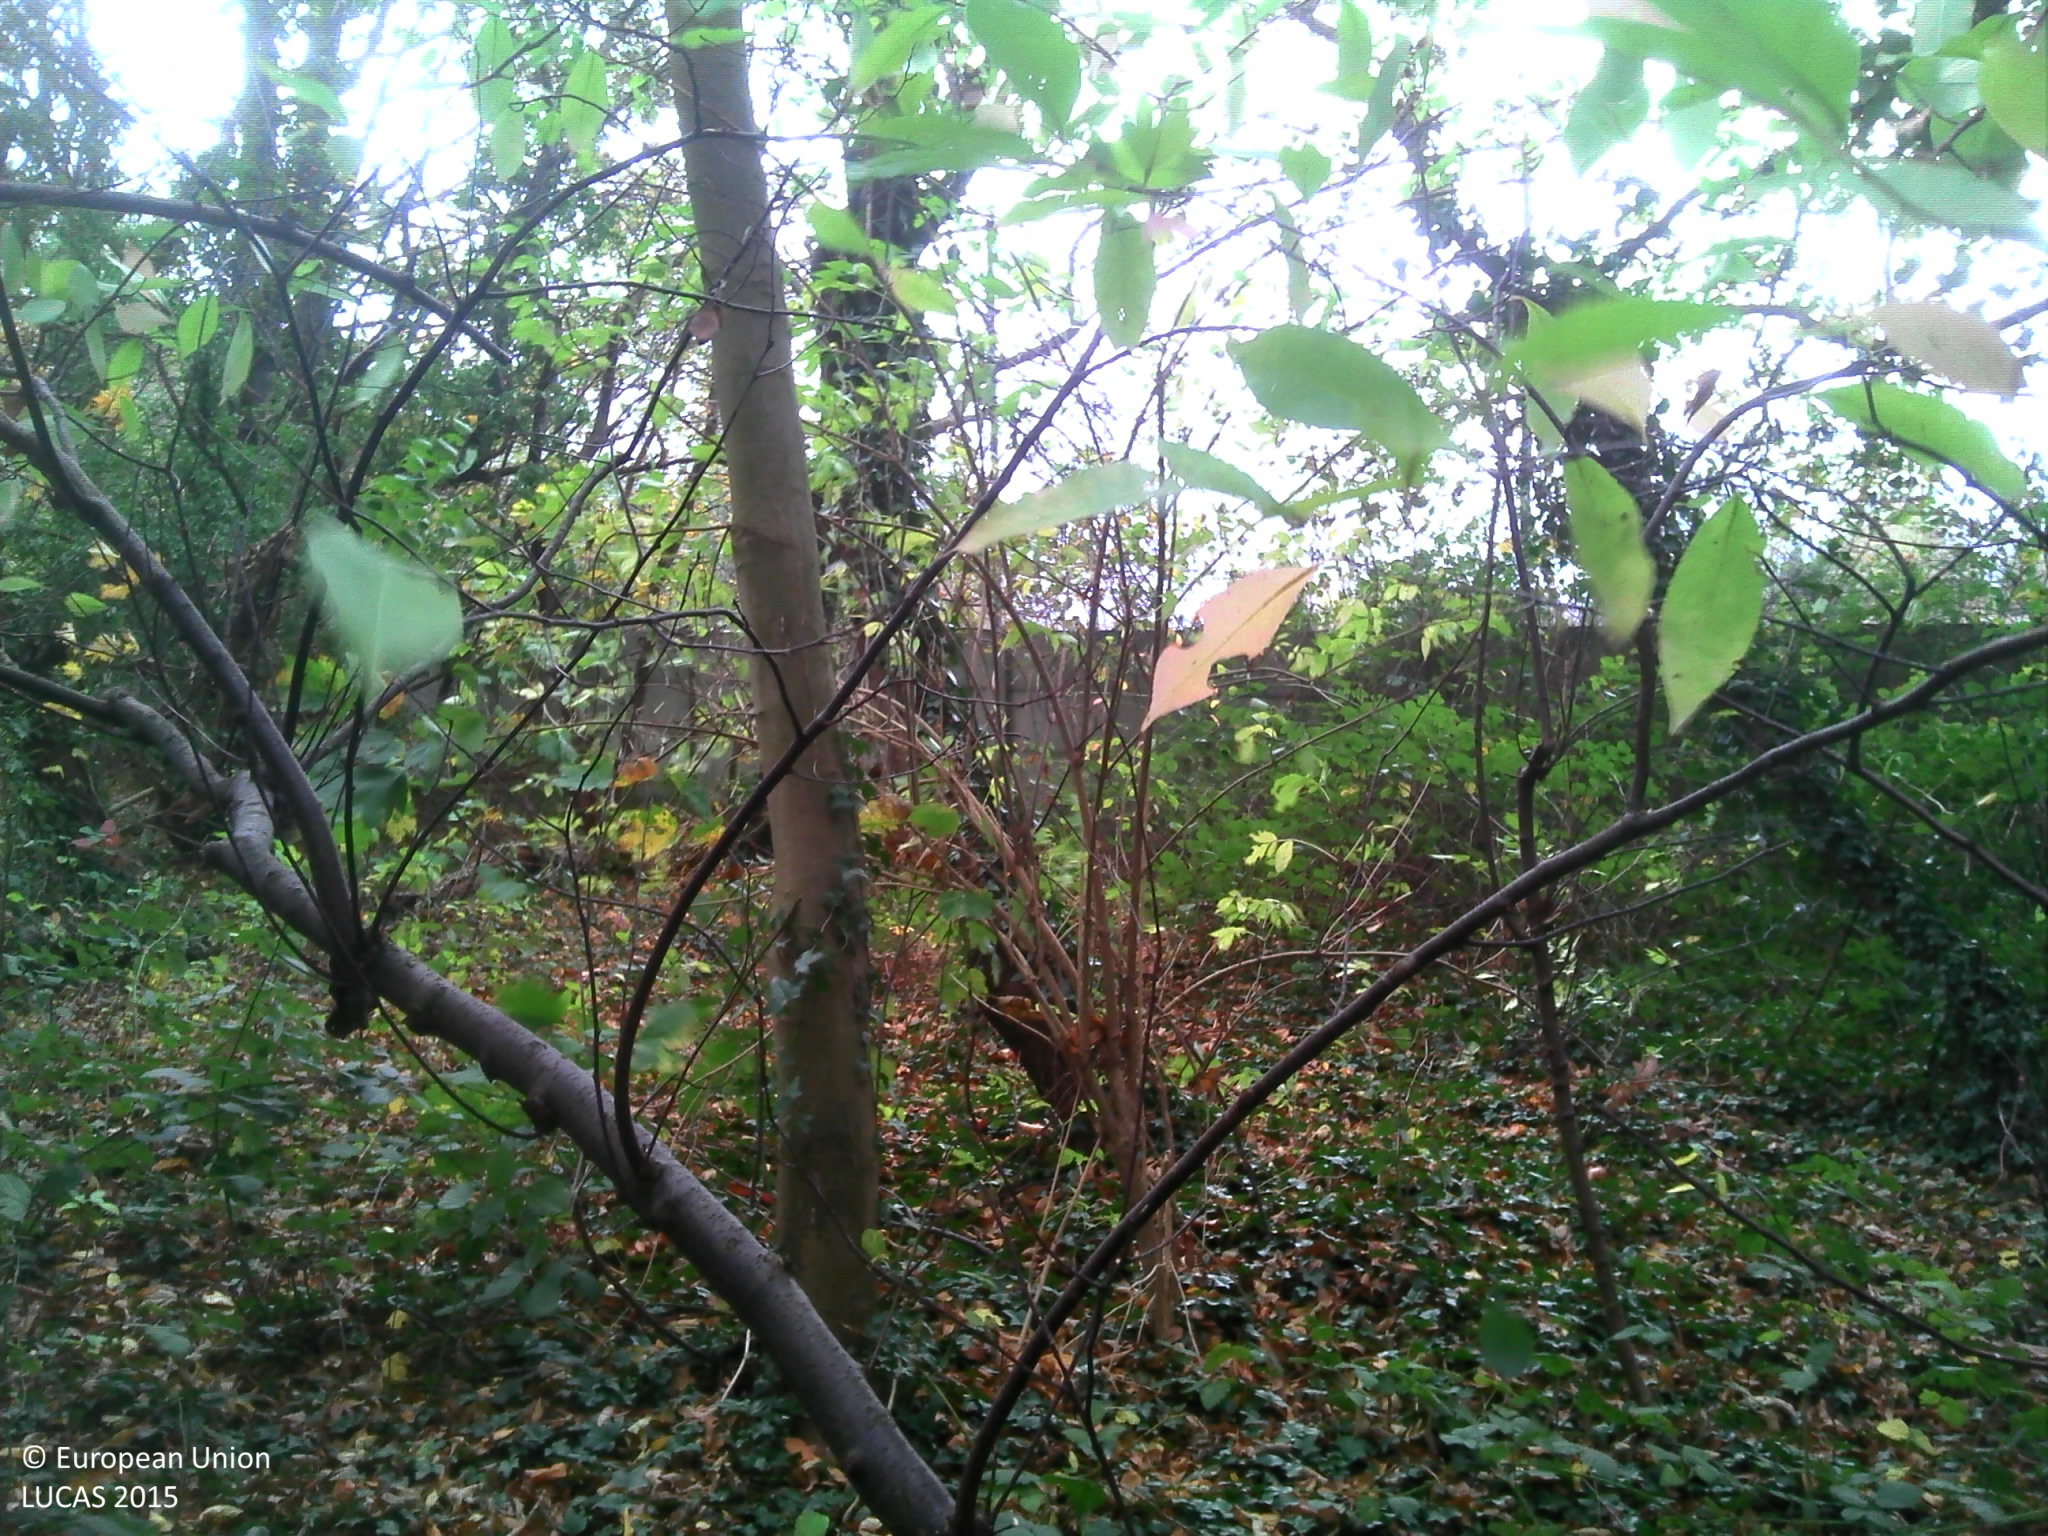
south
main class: Woodland
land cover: Broadleaved woodland
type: mesophytic deciduous forest
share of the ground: > 75 %
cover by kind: broadleaved forest trees 95 %, herbaceous plants 5 %
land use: Forestry
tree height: > 5 m
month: November
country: BE
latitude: 51.0071
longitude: 4.5088
